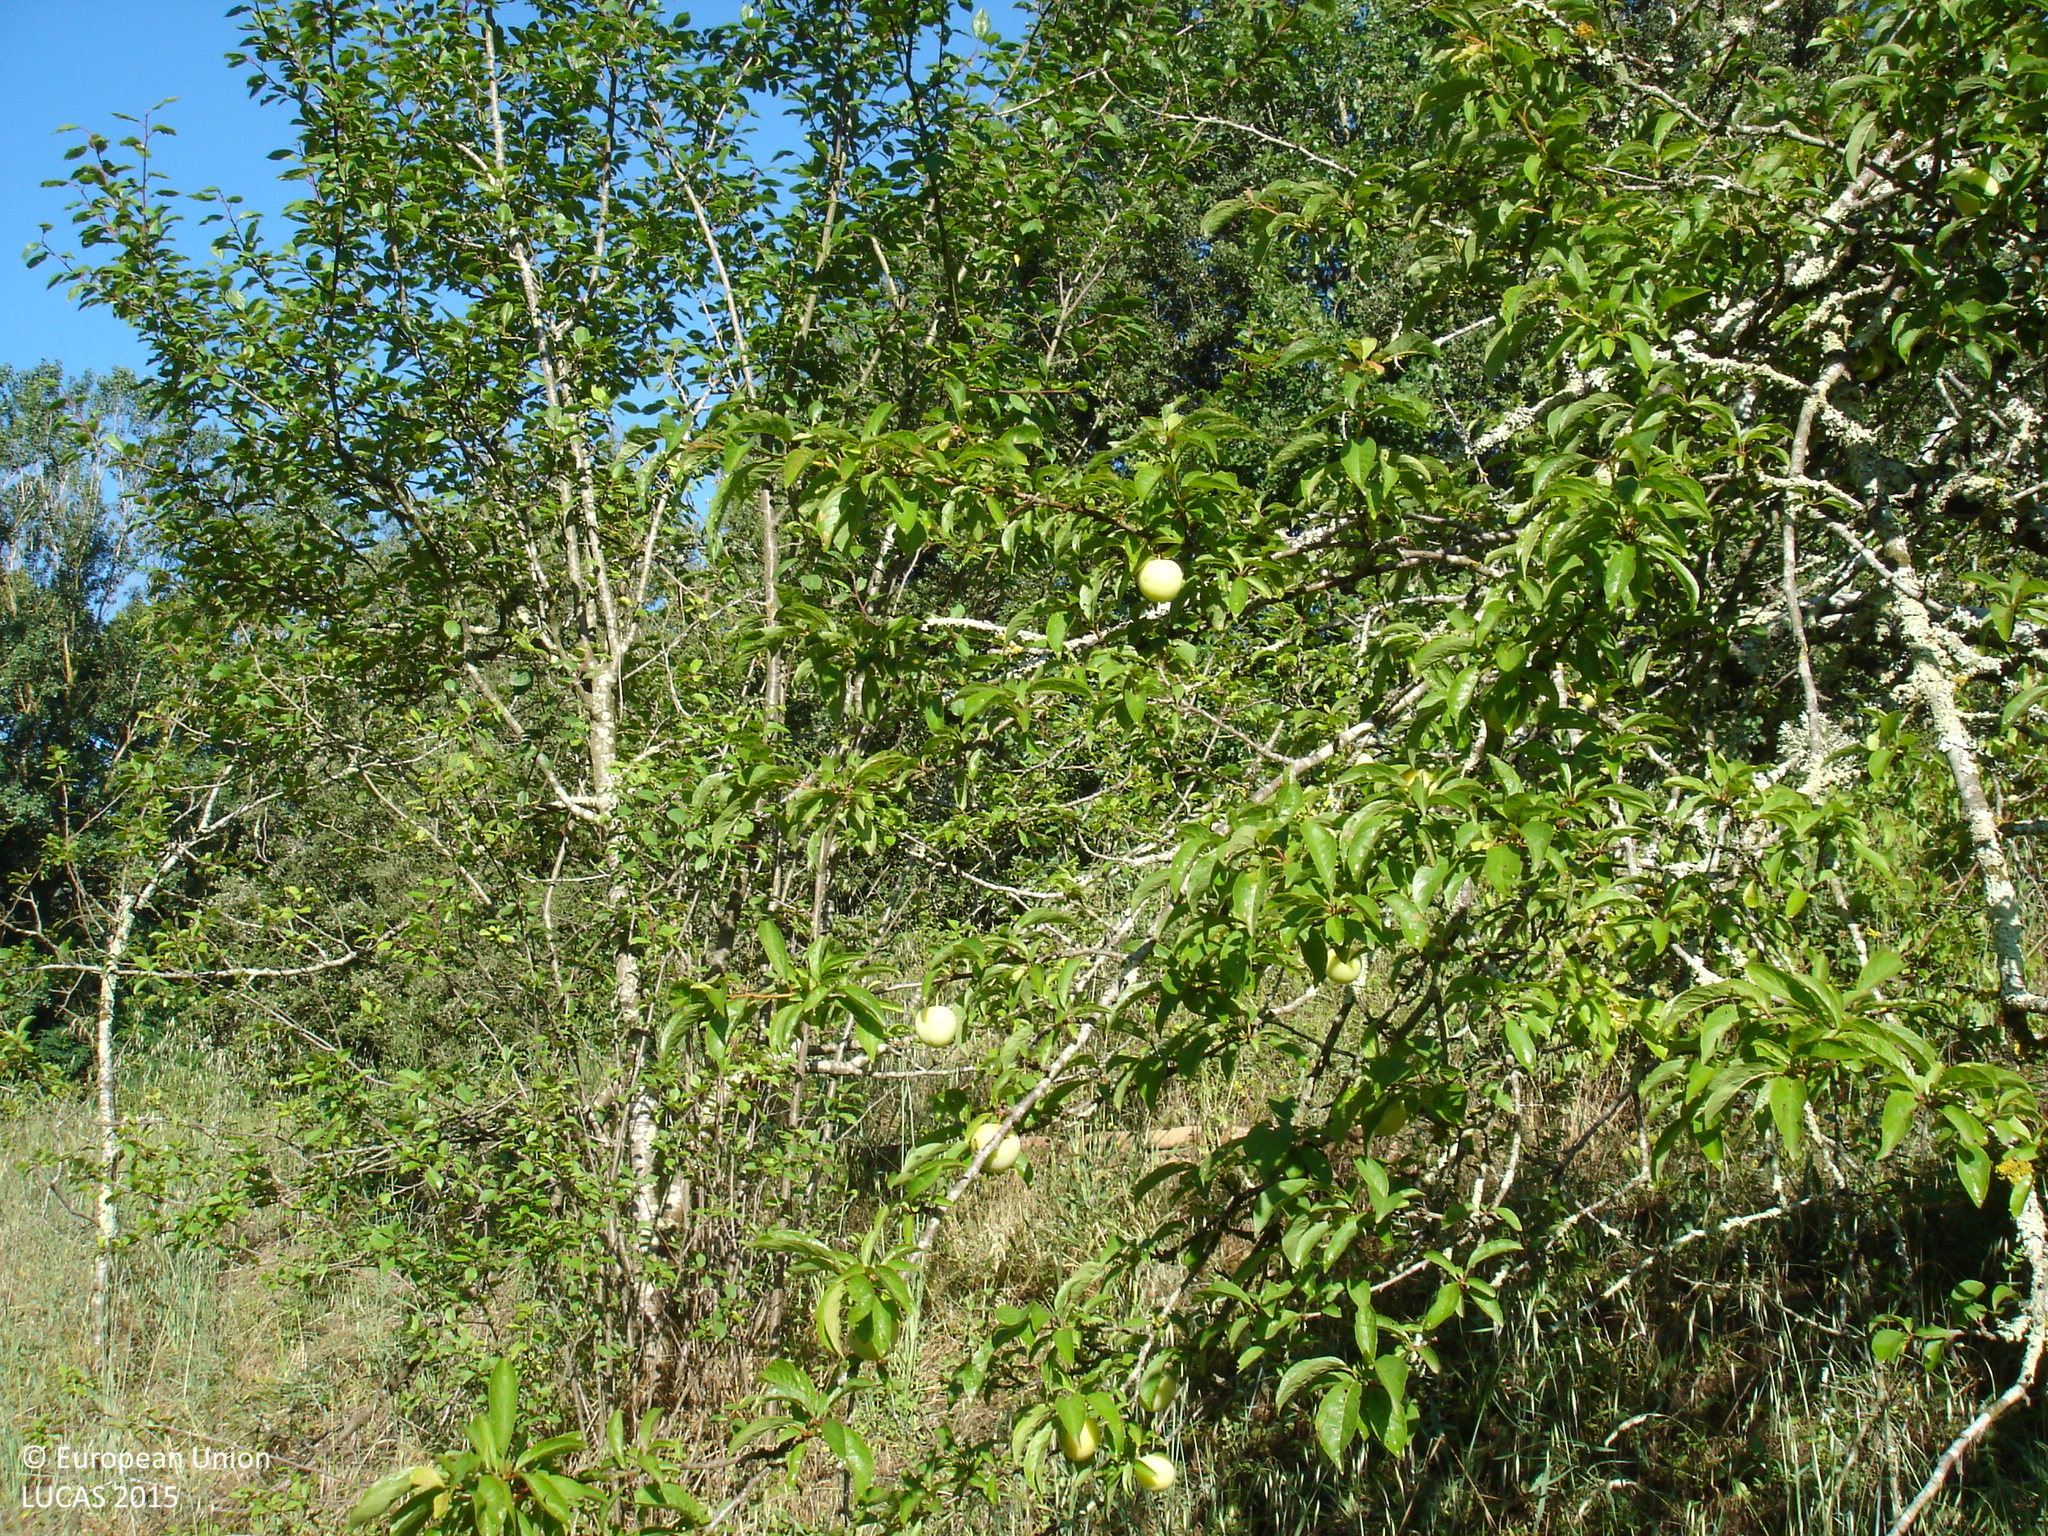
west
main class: Grassland
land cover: Spontaneously vegetated surfaces
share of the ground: > 75 %
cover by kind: herbaceous plants 95 %, shrubs 5 %
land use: Fallow land
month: June
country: ES
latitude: 41.7985
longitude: 2.5425
